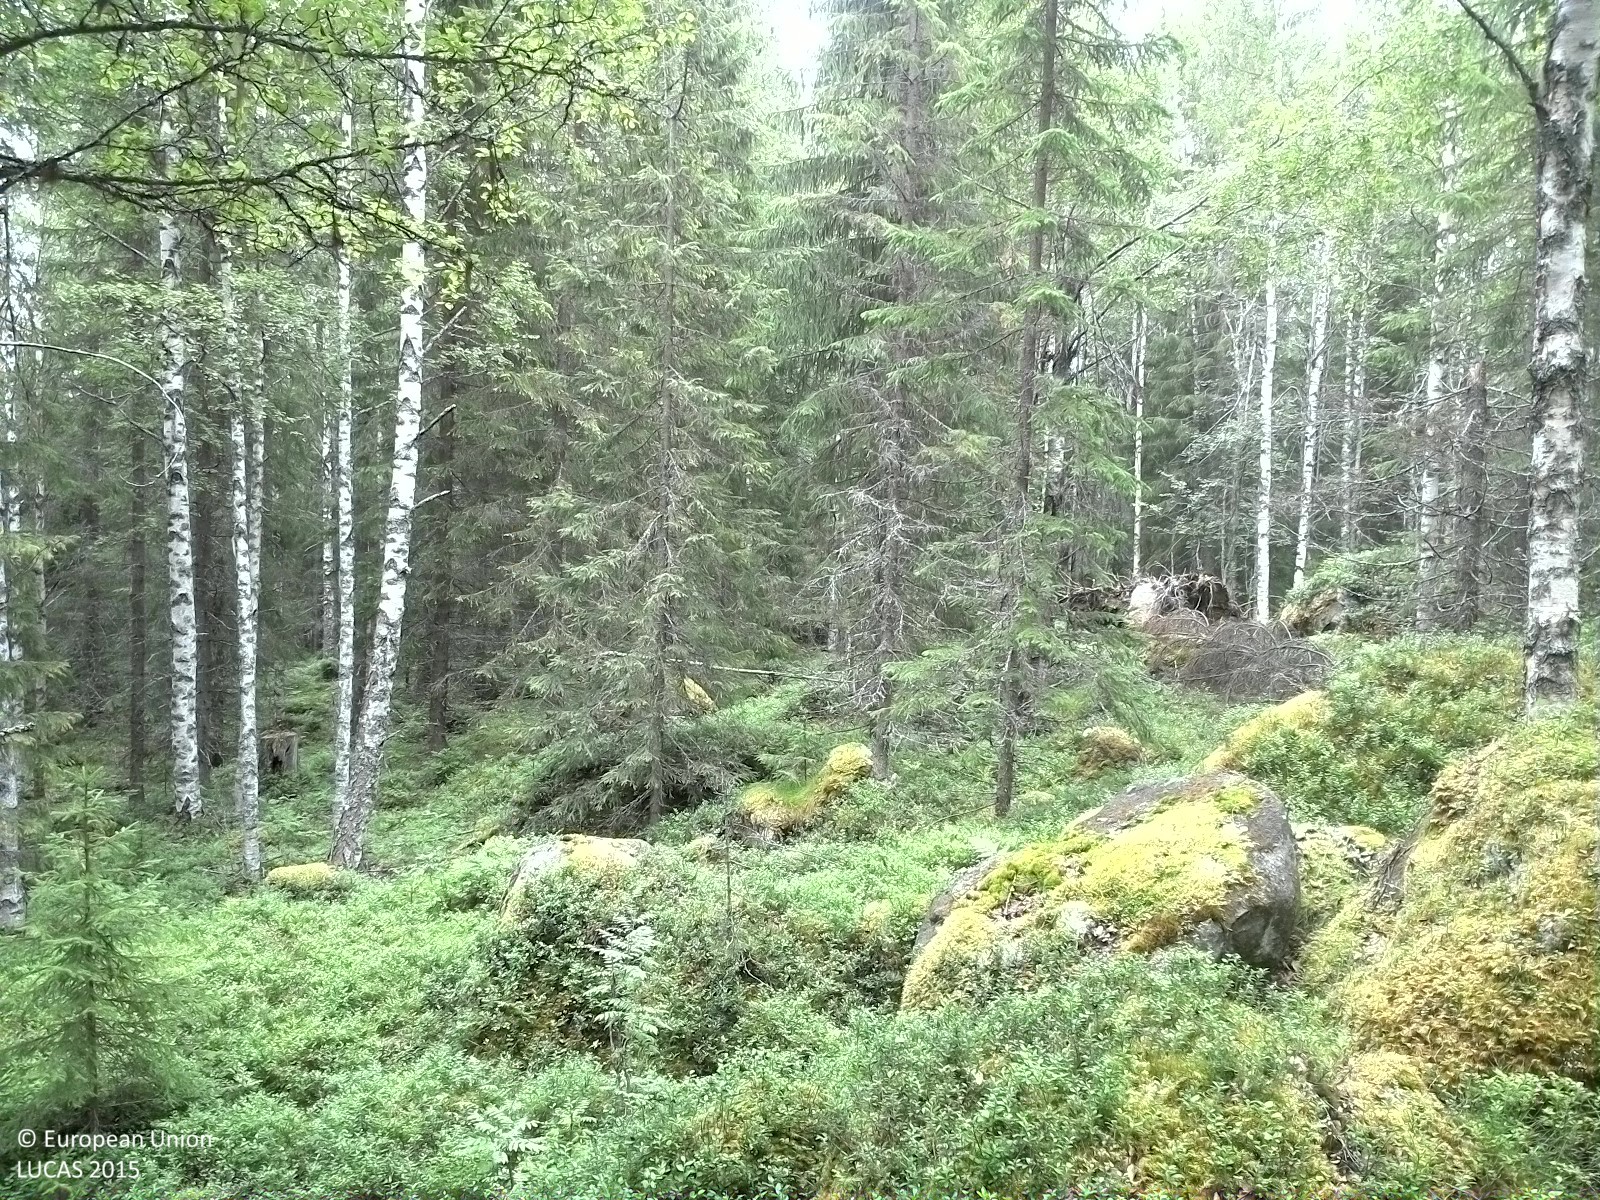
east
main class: Woodland
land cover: Other mixed woodland
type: boreal forest
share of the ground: 50 - 75 %
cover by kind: shrubs 45 %, coniferous forest trees 30 %, broadleaved forest trees 25 %
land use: Forestry
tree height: > 5 m
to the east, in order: Other mixed woodland; Spruce dominated mixed woodland; Pine dominated mixed woodland
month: August
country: SE
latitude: 62.8138
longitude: 16.5498
